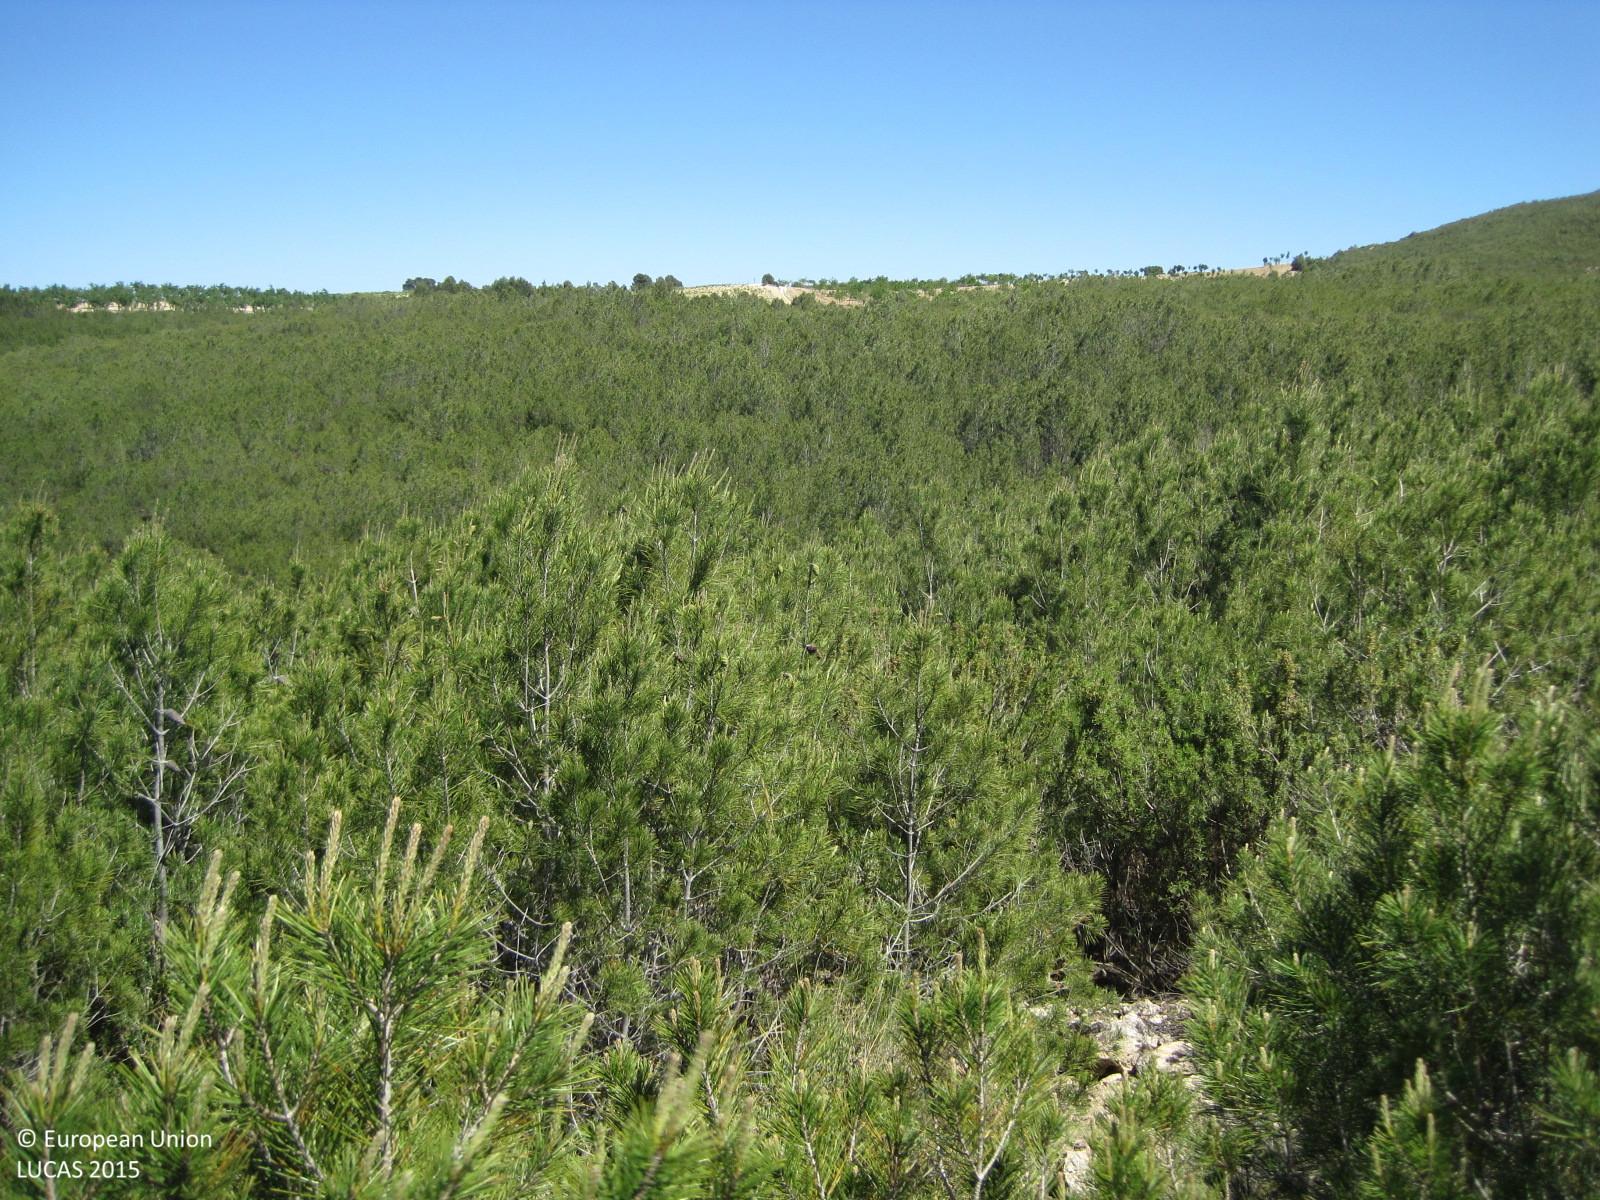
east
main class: Woodland
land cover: Pine dominated coniferous woodland
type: coniferous forest of the mediterranean region
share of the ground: > 75 %
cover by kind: coniferous forest trees 90 %, shrubs 10 %
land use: Forestry
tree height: < 5 m
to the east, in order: Pine dominated coniferous woodland; Tracks; Pine dominated coniferous woodland
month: May
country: ES
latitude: 39.3814
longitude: -1.0868
